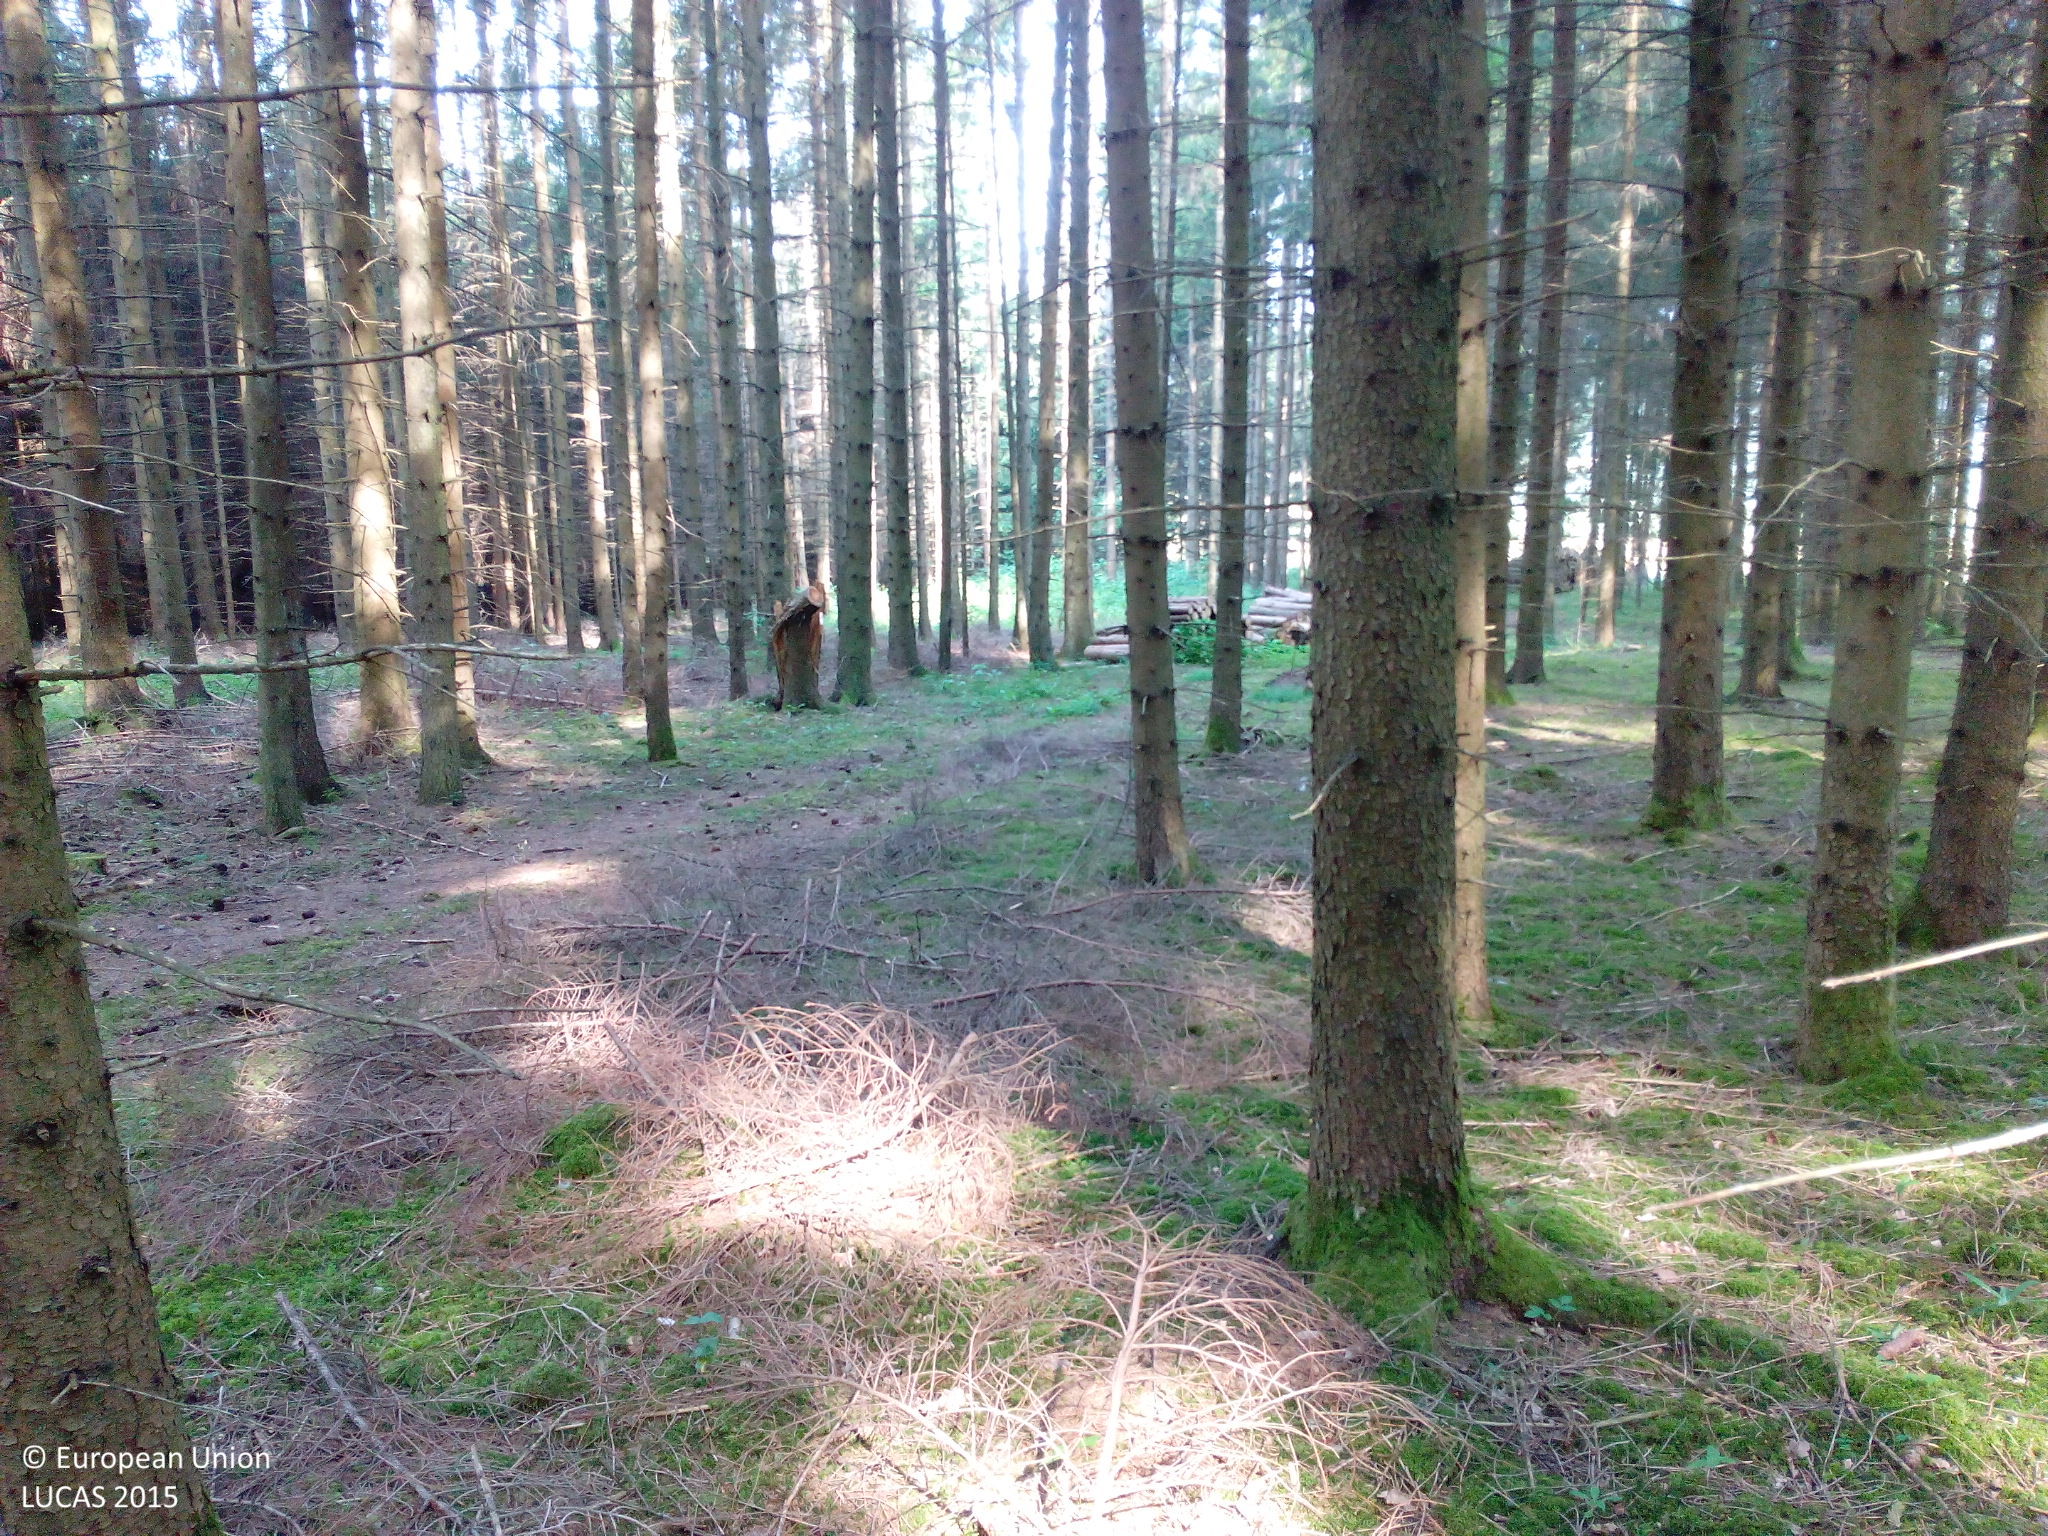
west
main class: Woodland
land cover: Spruce dominated coniferous woodland
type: hemiboreal forest and nemoral coniferous forest and mixed broadleaved-coniferous forest
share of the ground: > 75 %
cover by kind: coniferous forest trees 95 %, broadleaved forest trees 5 %
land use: Forestry
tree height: > 5 m
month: July
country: DE
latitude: 48.1854
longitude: 9.3144
